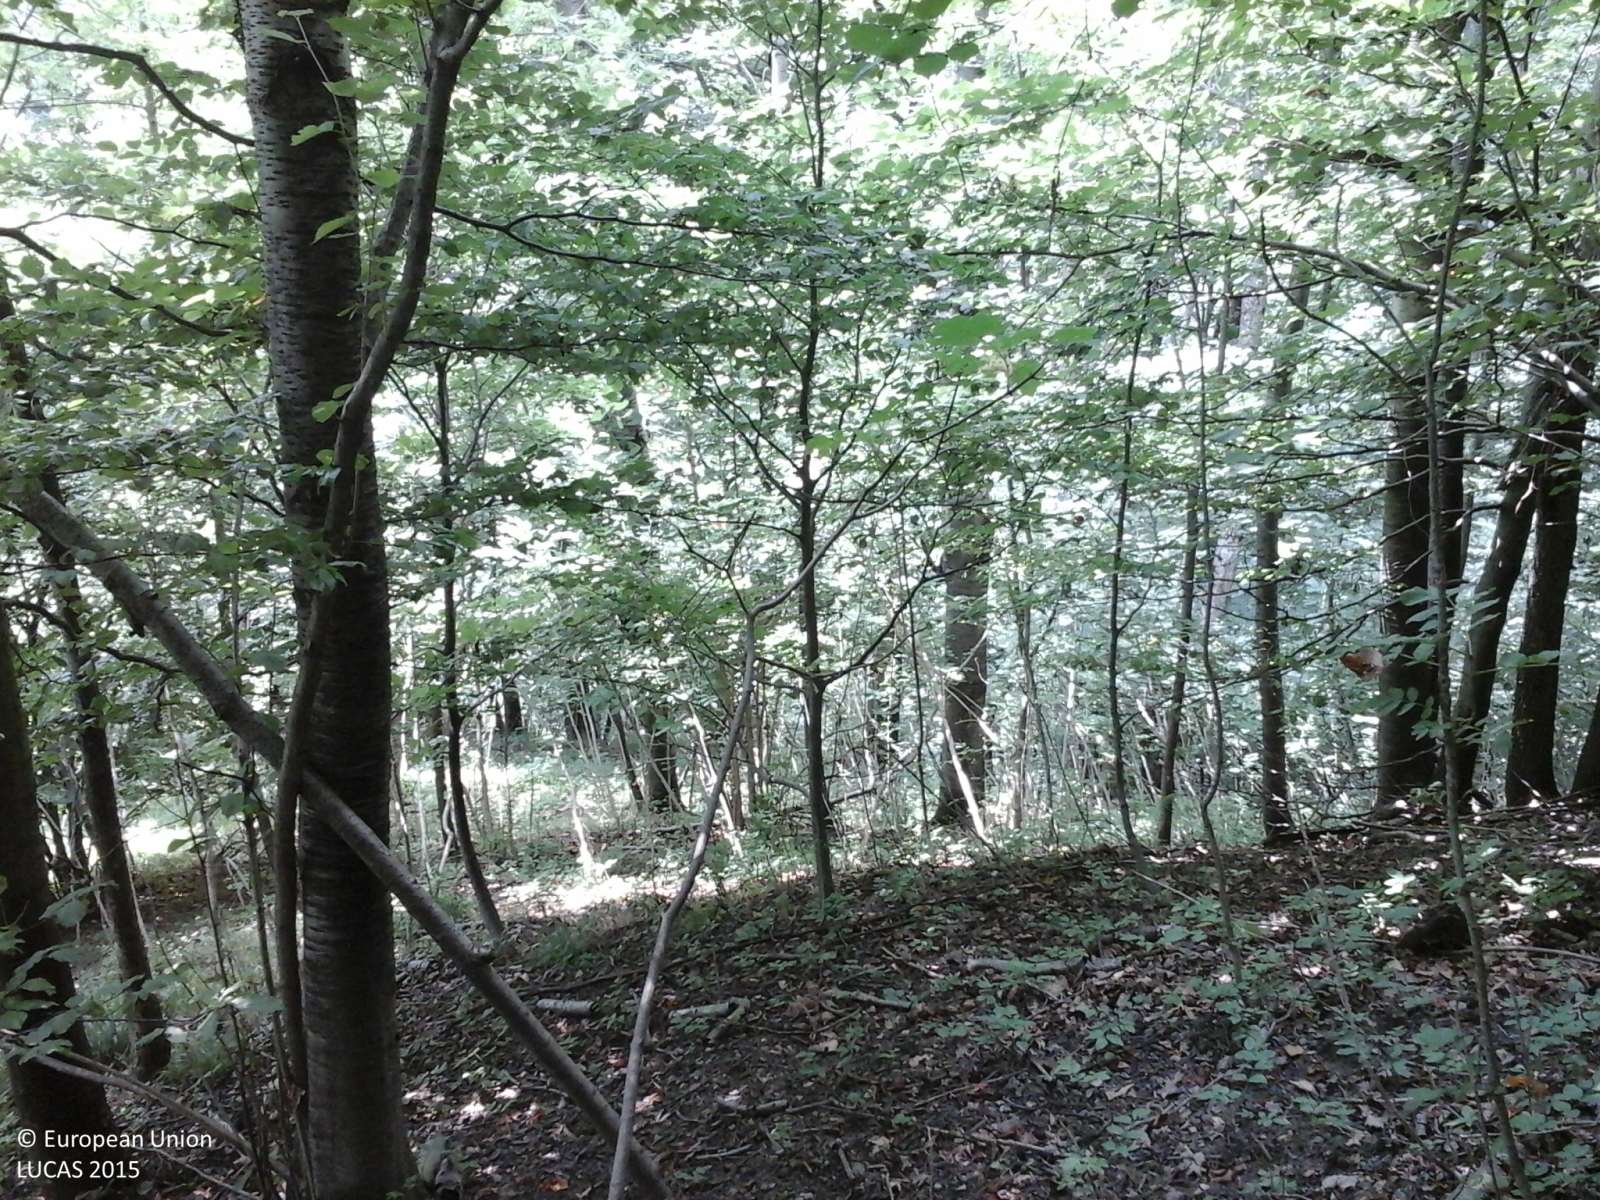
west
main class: Woodland
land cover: Broadleaved woodland
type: beech forest
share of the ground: > 75 %
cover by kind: broadleaved forest trees 100 %
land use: Semi-natural and natural areas not in use
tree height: > 5 m
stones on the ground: 10 - 25 %
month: July
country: IT
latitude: 45.2353
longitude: 7.2911
